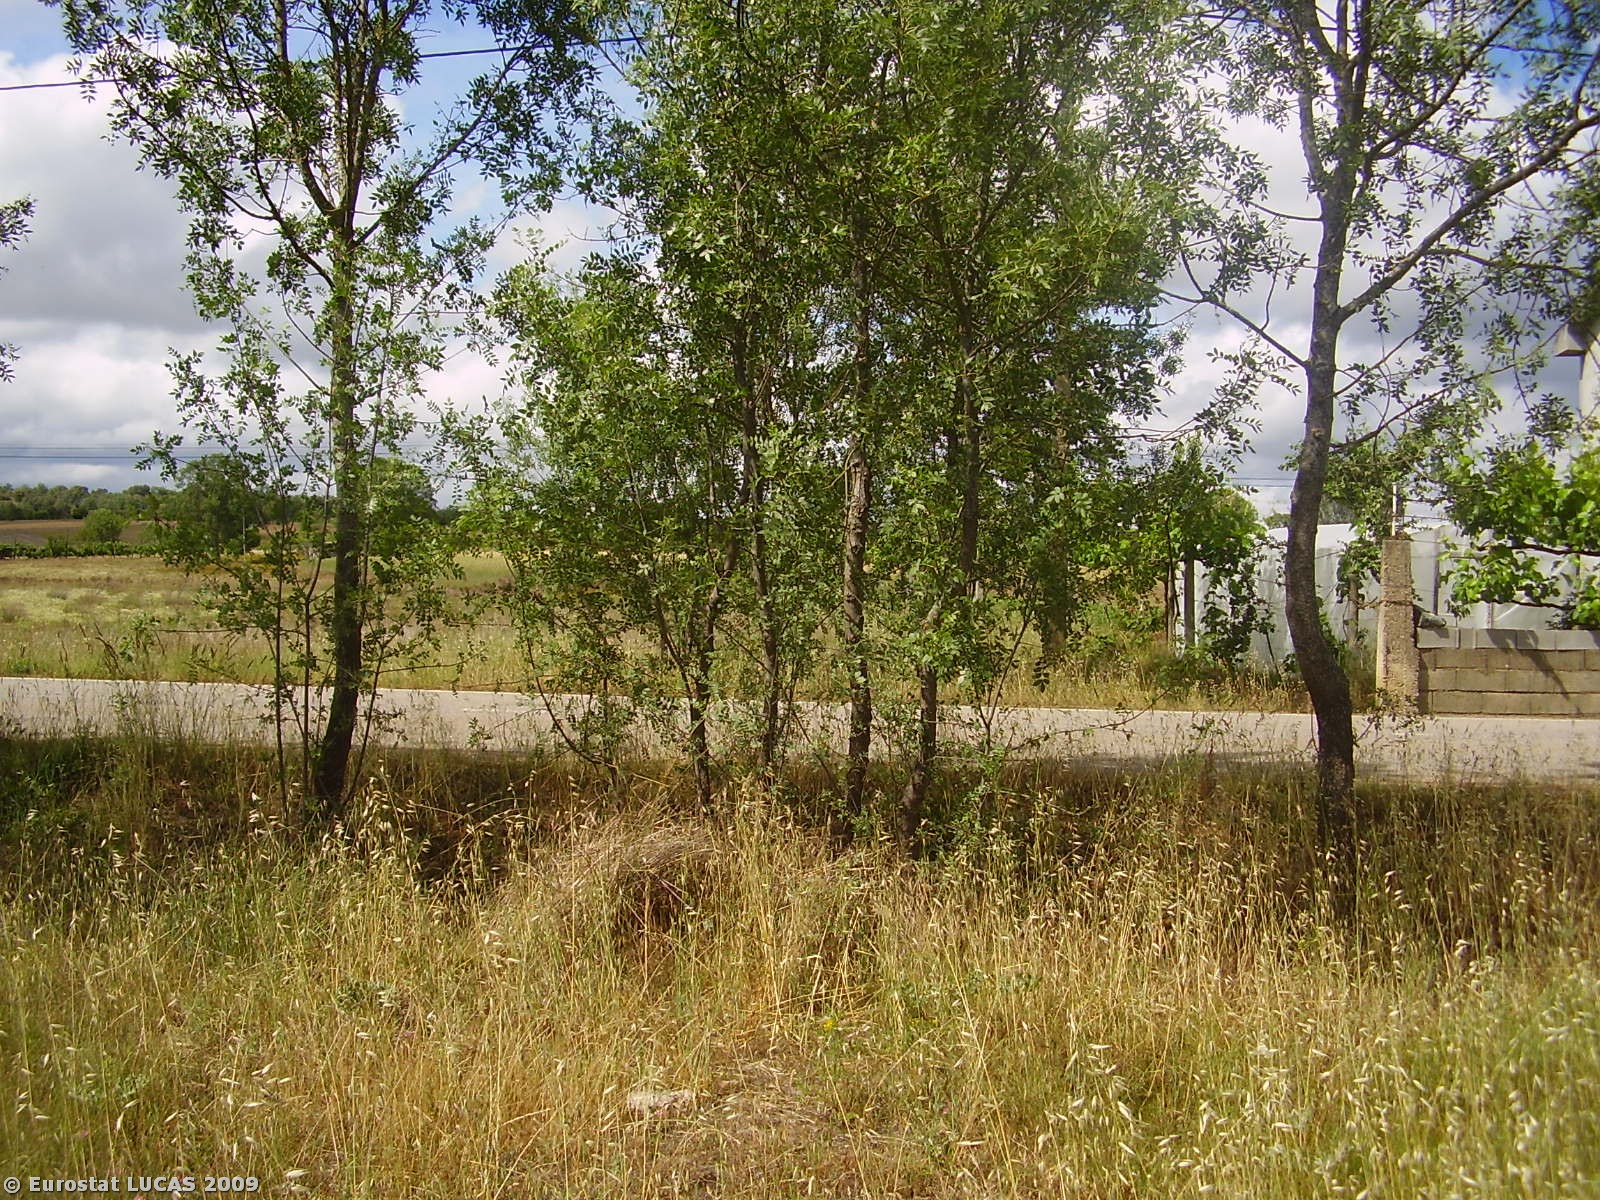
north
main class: Cropland
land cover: Temporary grasslands
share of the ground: > 75 %
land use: Agriculture (excluding fallow land and kitchen gardens)
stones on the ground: 10 - 25 %
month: June
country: PT
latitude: 41.5245
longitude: -6.8530
